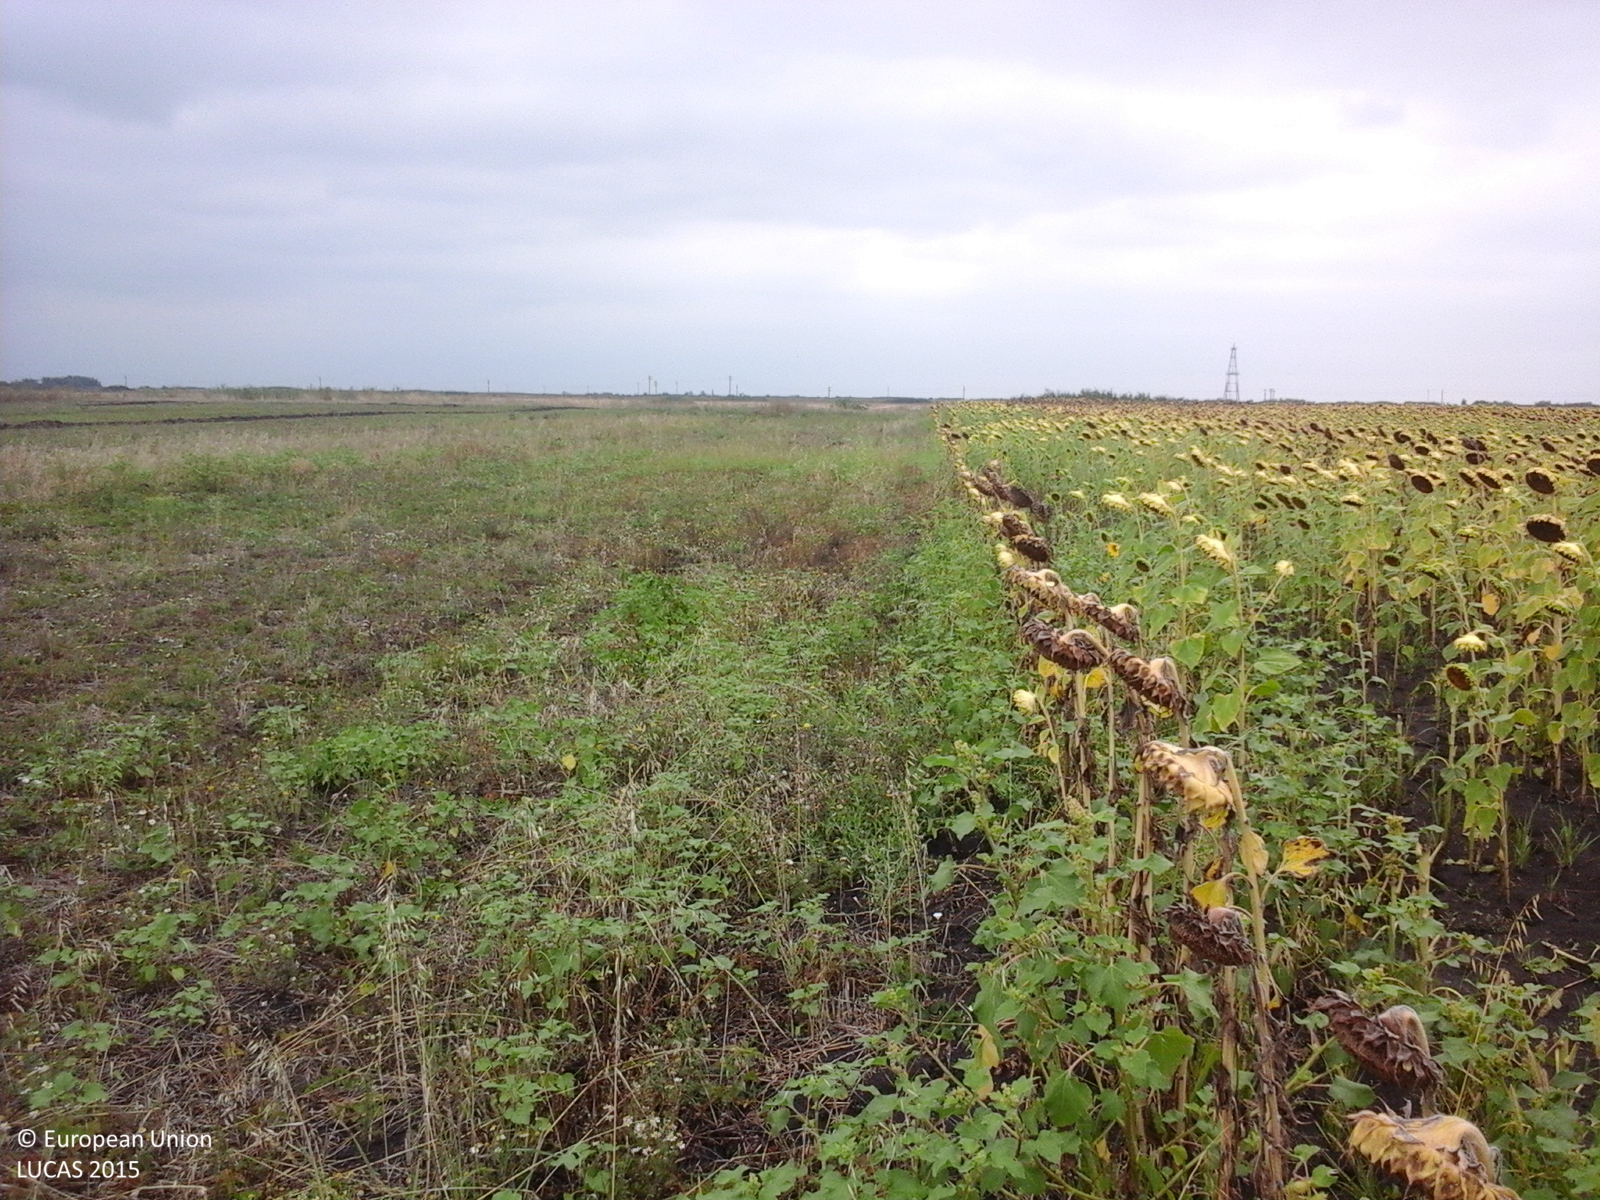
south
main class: Cropland
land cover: Sunflower
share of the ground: > 75 %
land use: Agriculture (excluding fallow land and kitchen gardens)
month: August
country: RO
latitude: 46.1316
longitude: 20.4173
